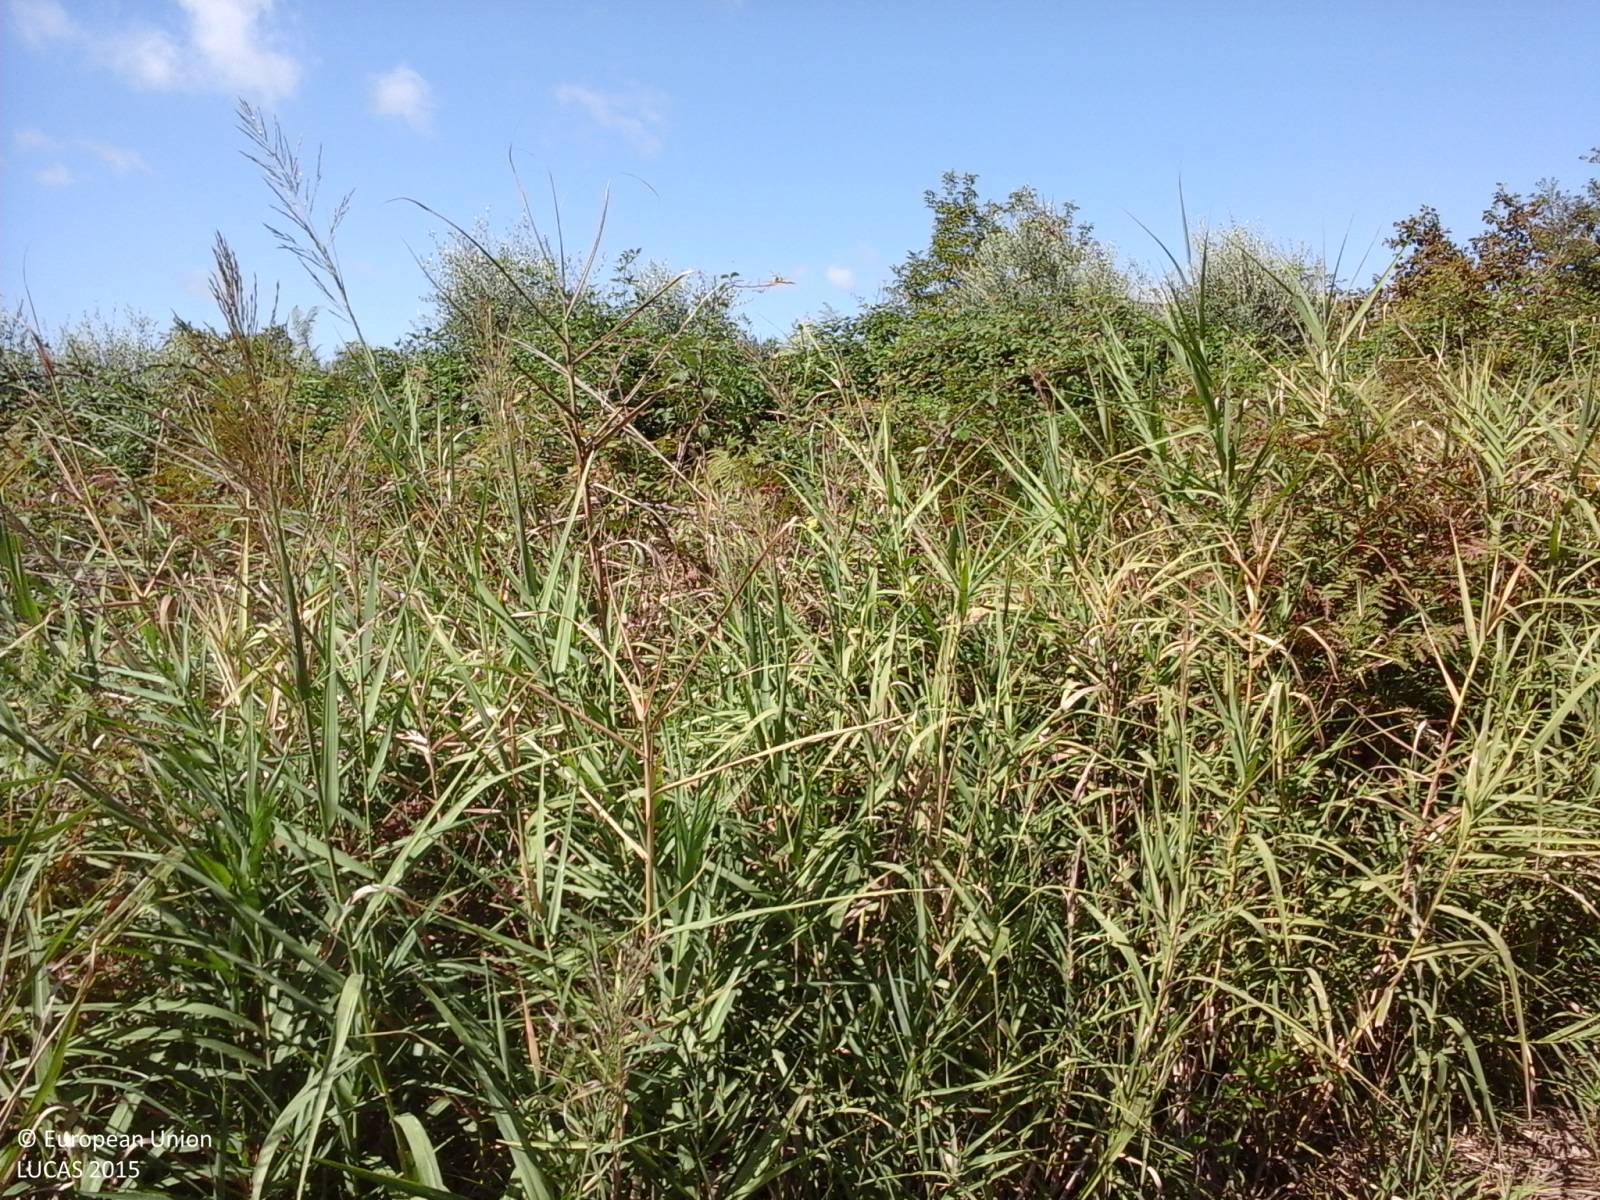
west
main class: Shrubland
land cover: Shrubland without tree cover
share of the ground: > 75 %
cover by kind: shrubs 100 %
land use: Agriculture (excluding fallow land and kitchen gardens)
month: September
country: IT
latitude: 42.2960
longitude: 12.5747
